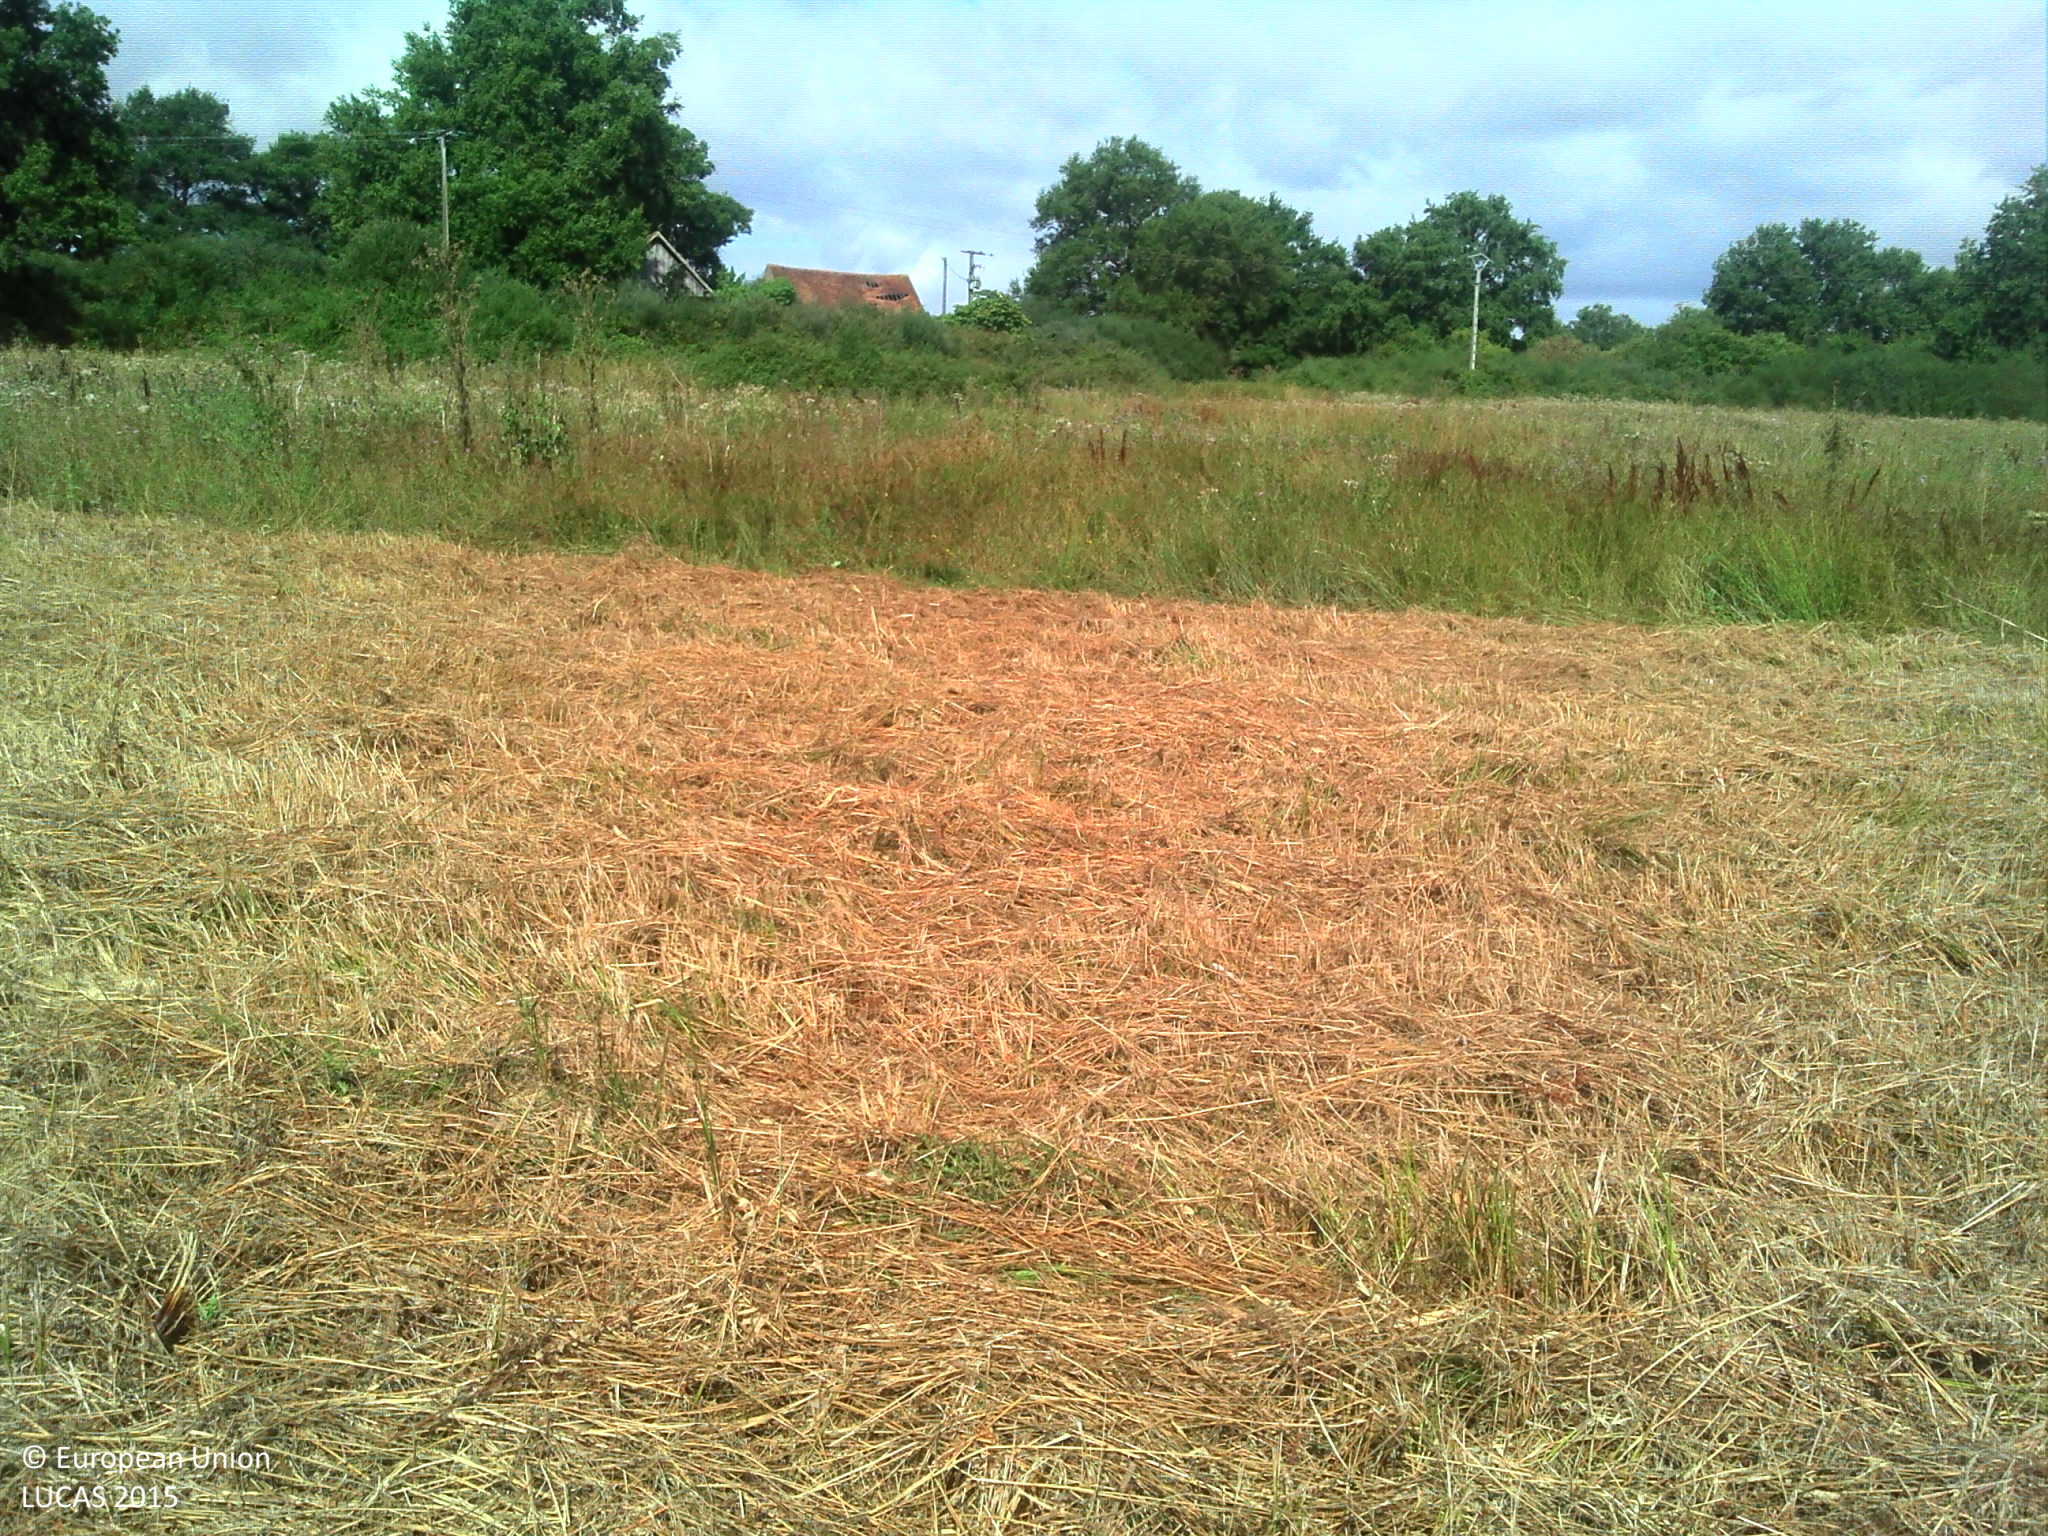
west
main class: Grassland
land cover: Grassland without tree/shrub cover
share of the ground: > 75 %
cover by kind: herbaceous plants 100 %
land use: Agriculture (excluding fallow land and kitchen gardens)
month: July
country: FR
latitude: 46.2780
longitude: 1.2028
